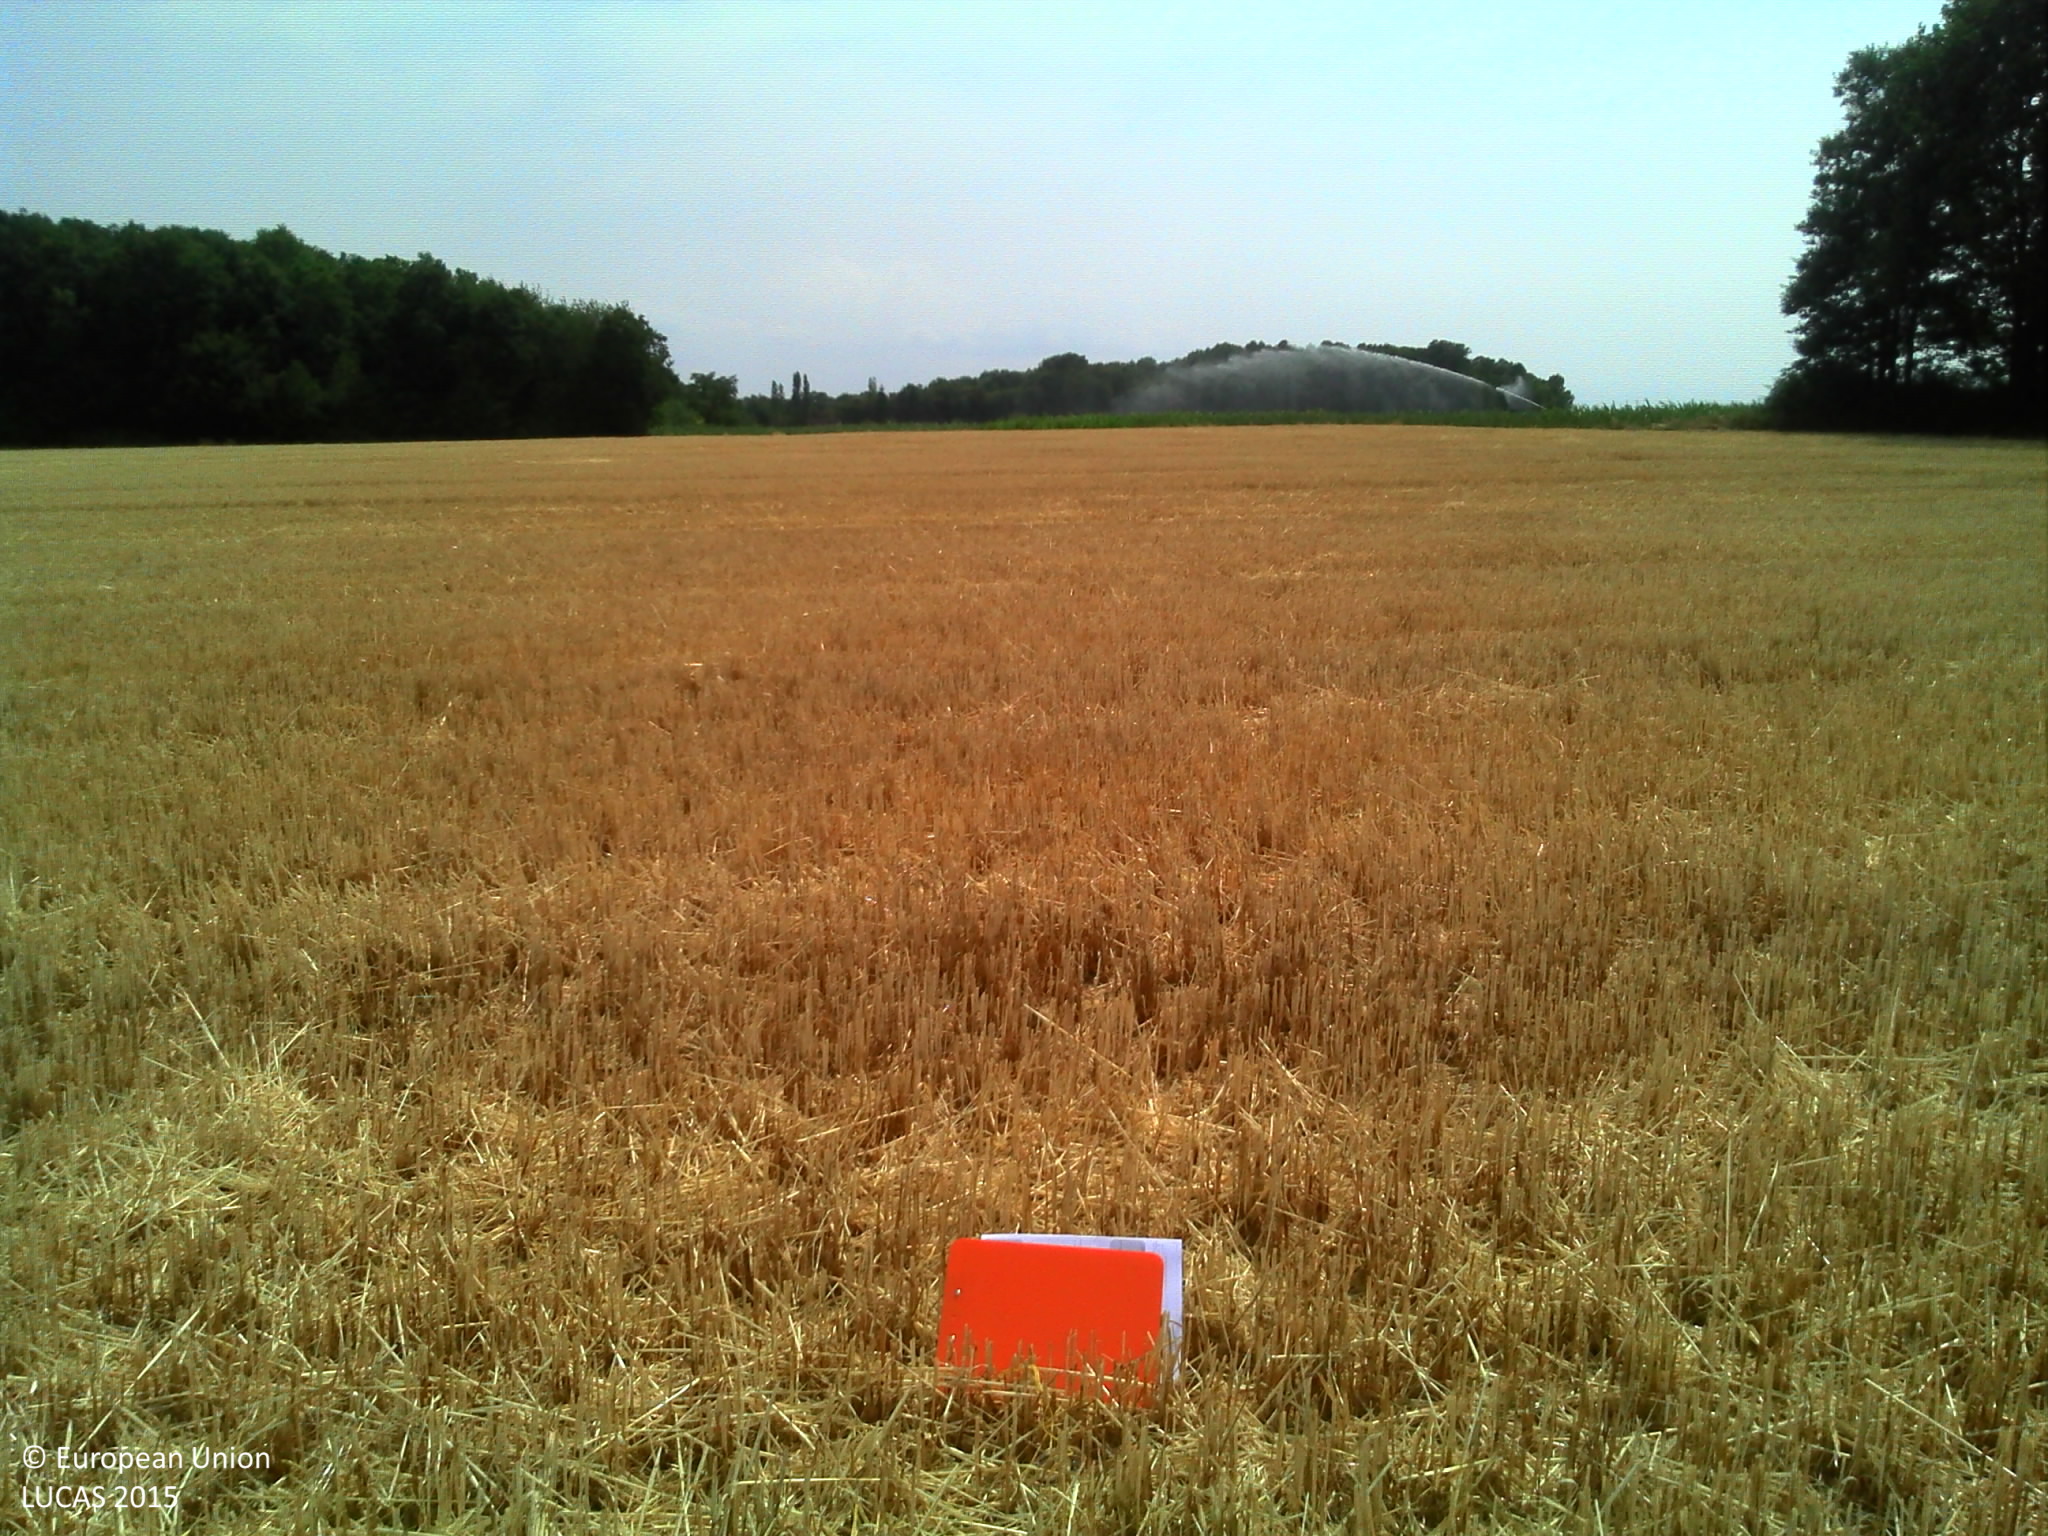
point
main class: Cropland
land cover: Barley
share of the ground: > 75 %
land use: Agriculture (excluding fallow land and kitchen gardens)
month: July
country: FR
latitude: 47.9716
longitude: 2.8257
